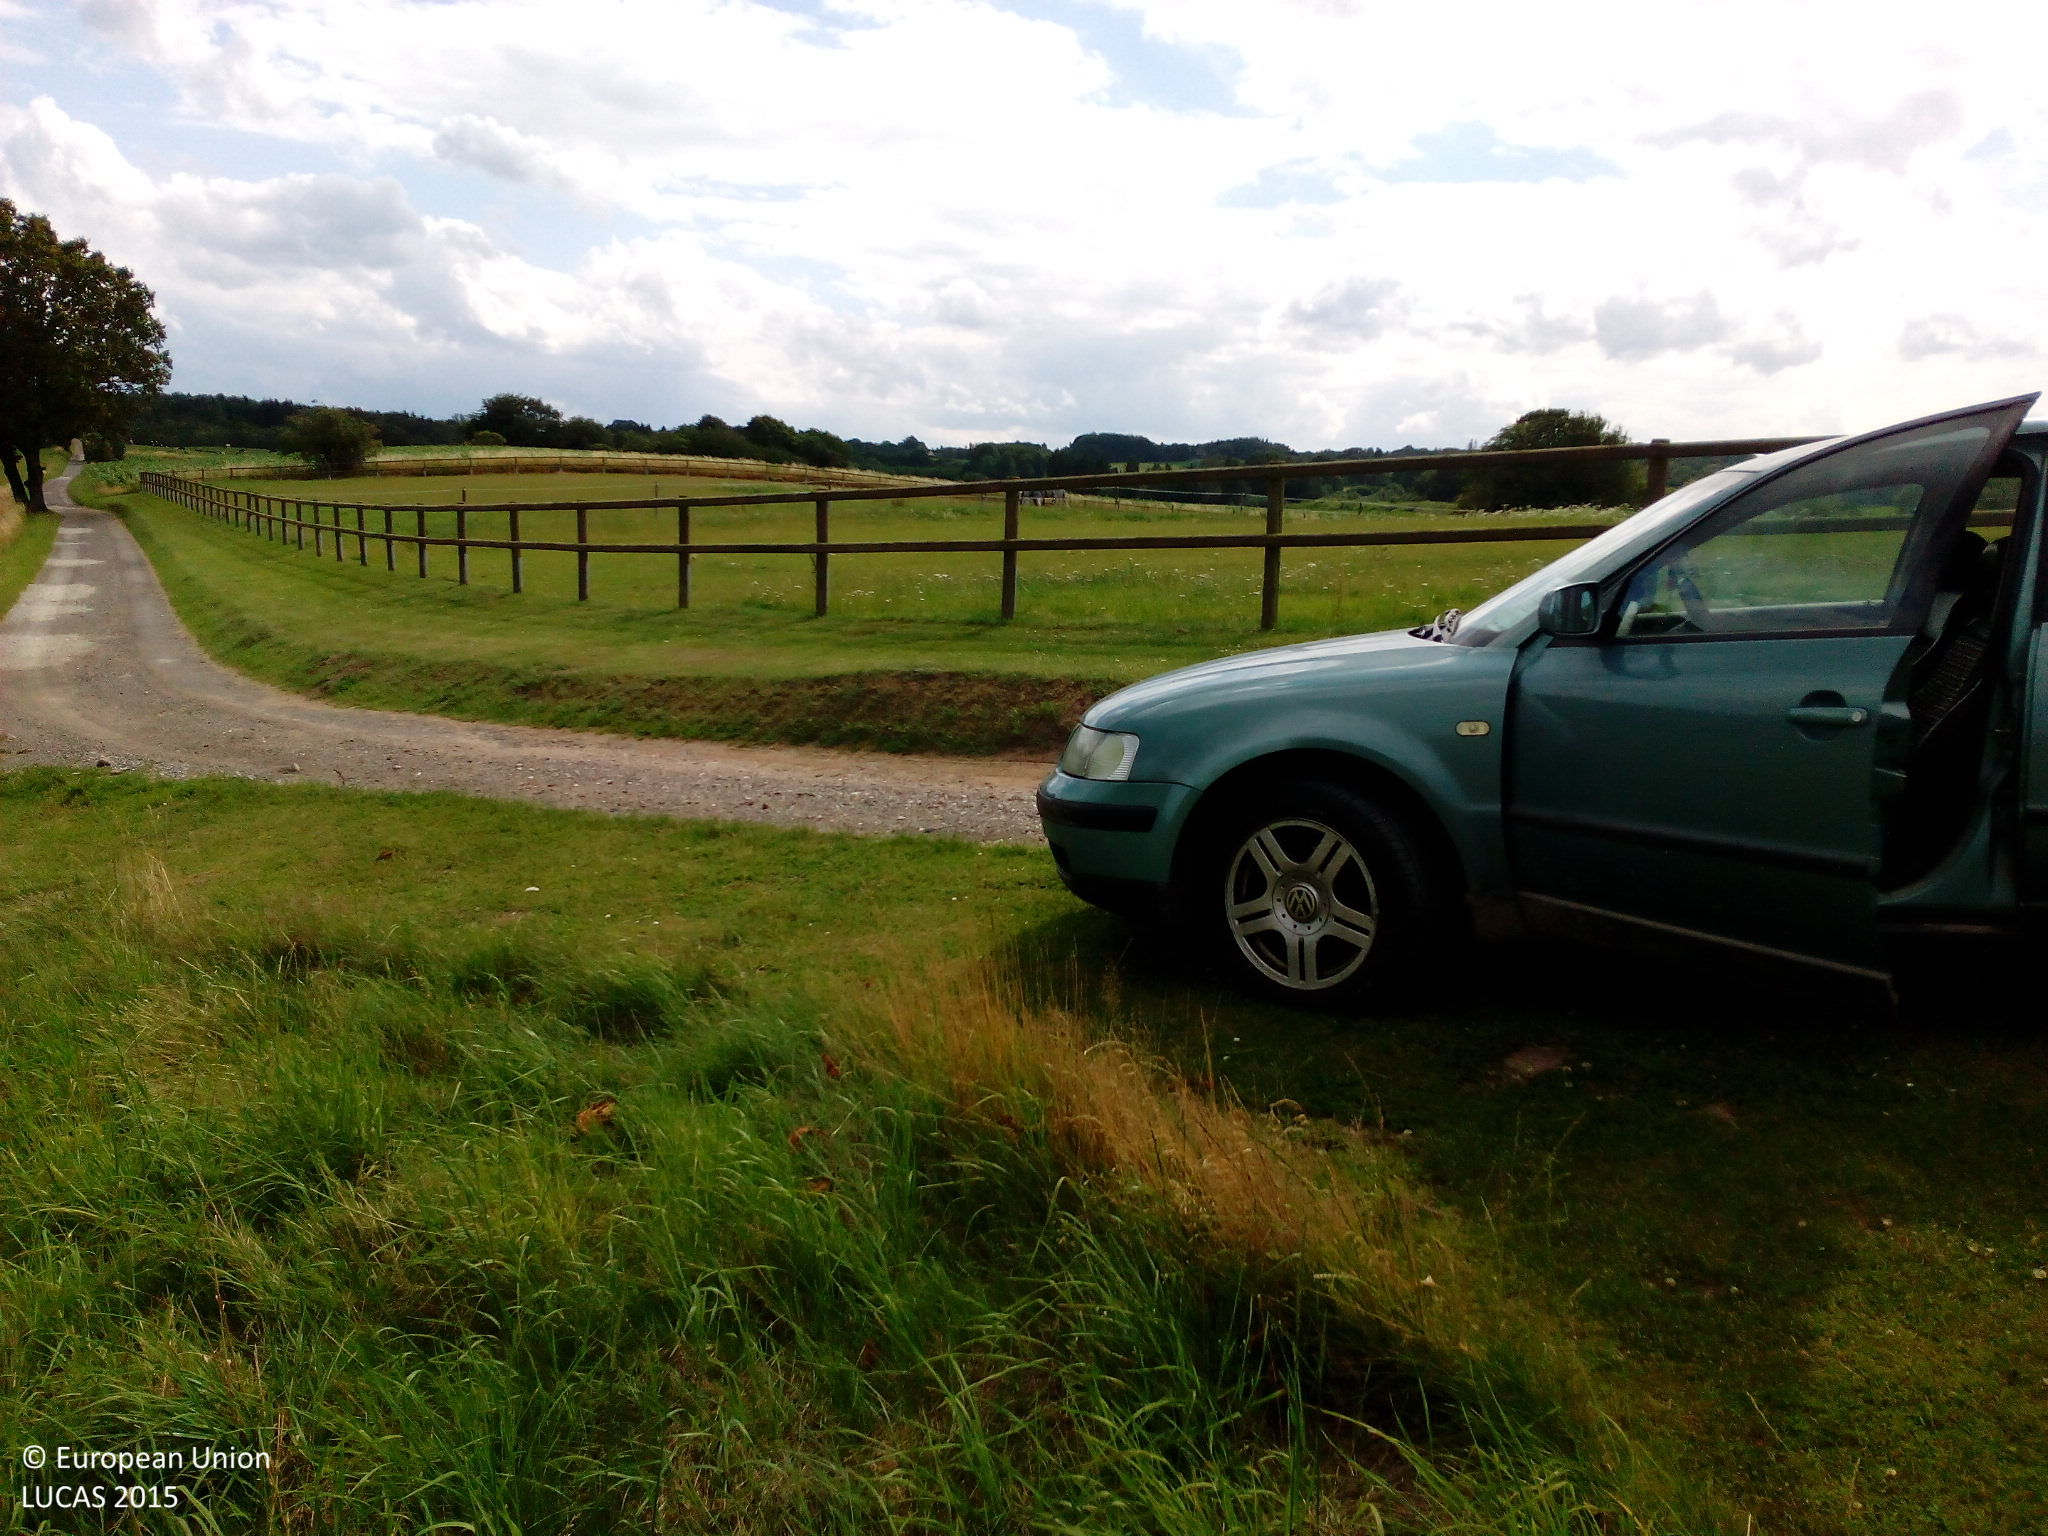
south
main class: Grassland
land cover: Grassland without tree/shrub cover
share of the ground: > 75 %
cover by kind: herbaceous plants 100 %
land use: Agriculture (excluding fallow land and kitchen gardens)
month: July
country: DK
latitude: 56.0582
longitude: 12.3584
